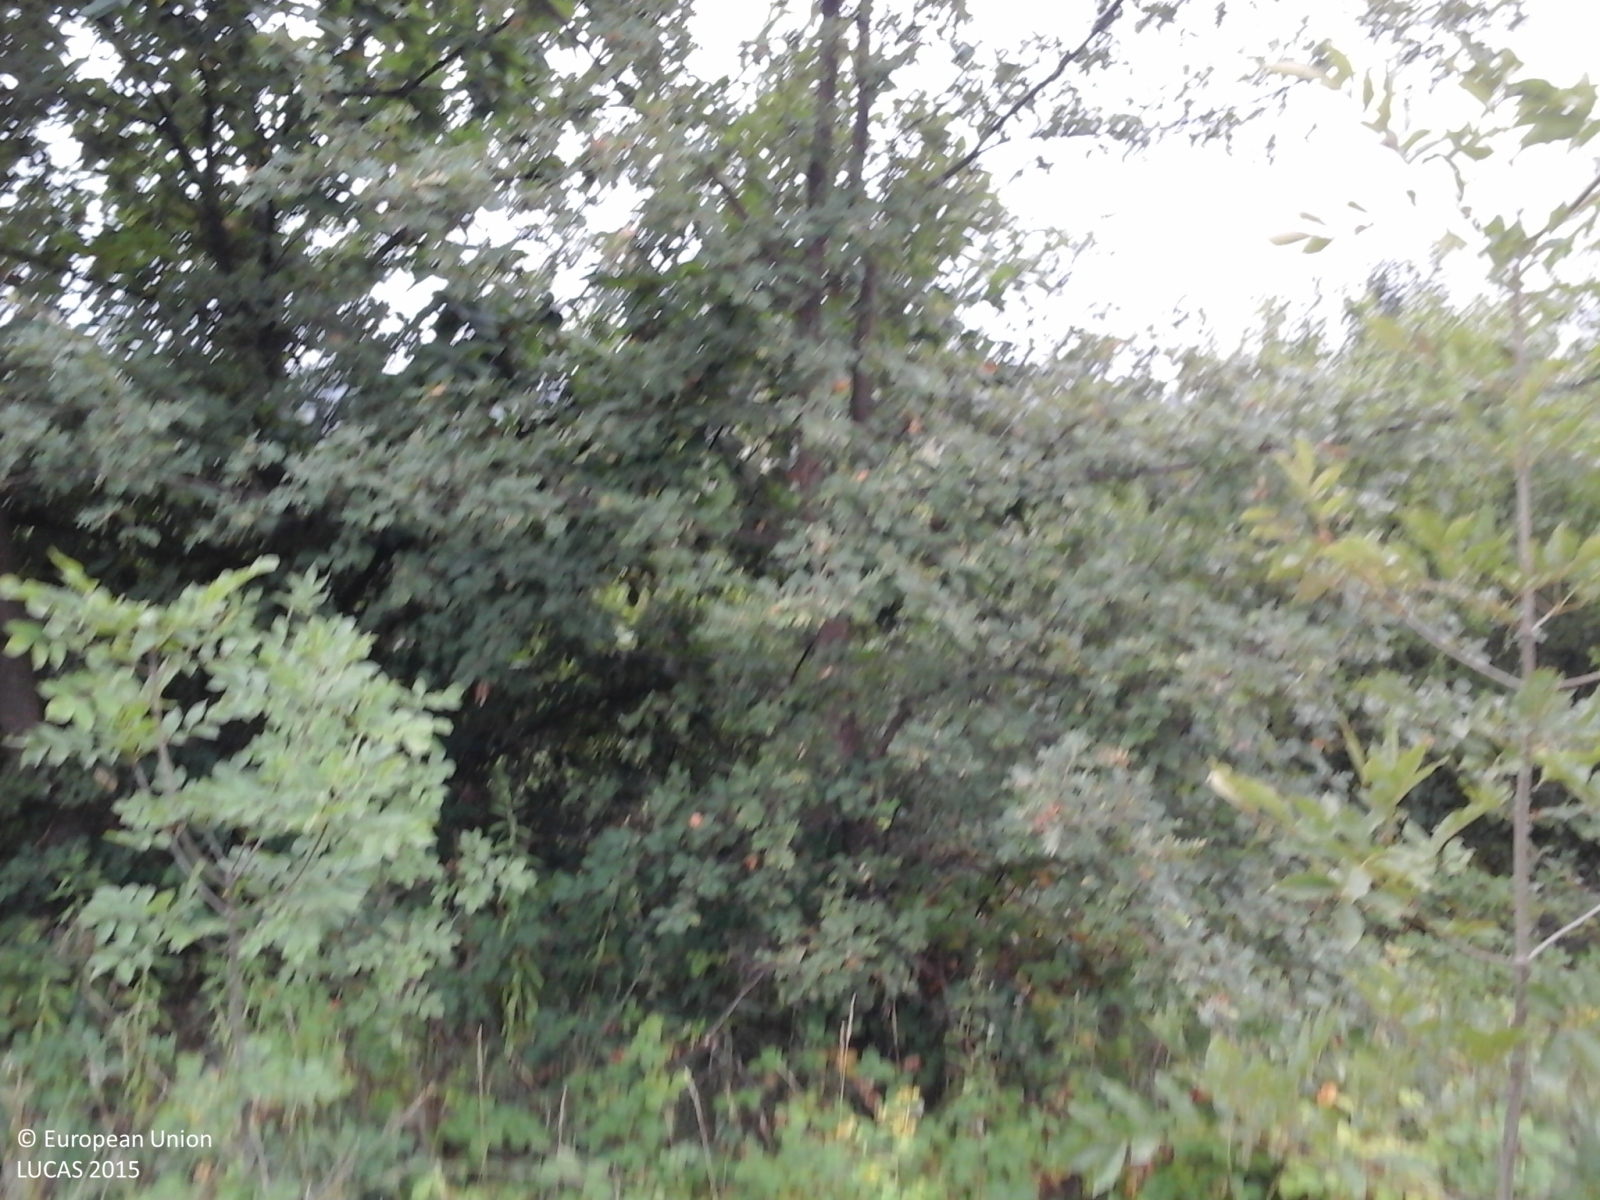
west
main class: Grassland
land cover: Grassland with sparse tree/shrub cover
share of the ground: > 75 %
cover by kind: herbaceous plants 85 %, broadleaved forest trees 5 %, shrubs 5 %, lichens and mosses 5 %
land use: Semi-natural and natural areas not in use
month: July
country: IT
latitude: 44.4806
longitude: 8.2812
